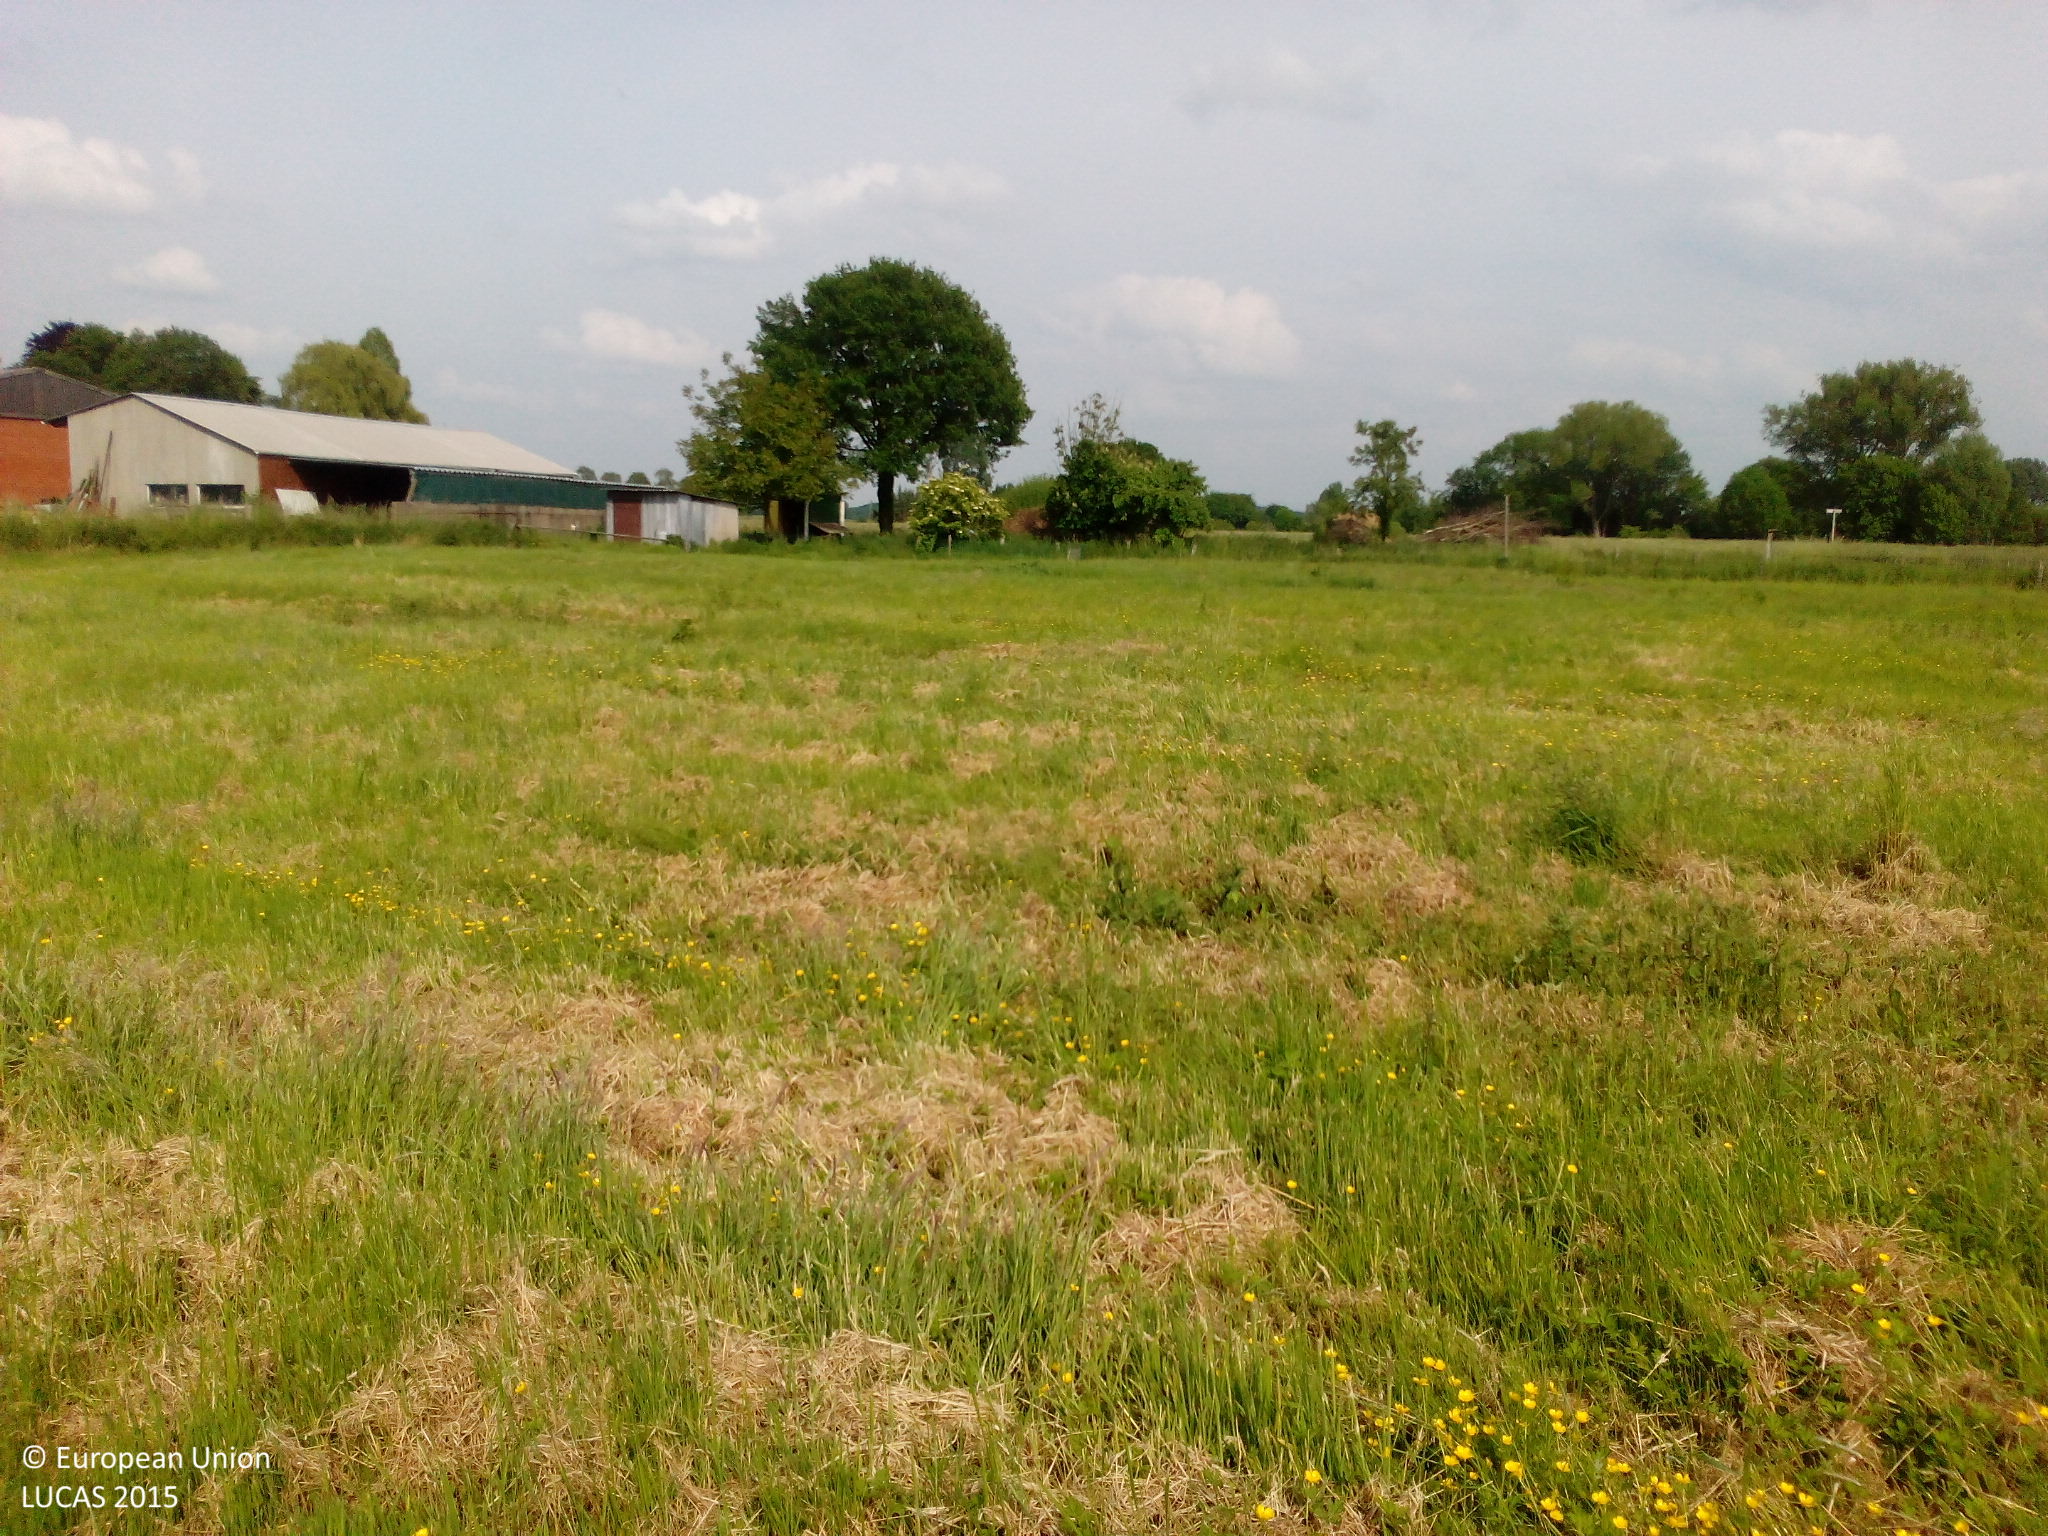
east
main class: Grassland
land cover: Grassland without tree/shrub cover
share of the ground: > 75 %
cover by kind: herbaceous plants 100 %
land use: Agriculture (excluding fallow land and kitchen gardens)
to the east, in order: Grassland without tree/shrub cover; Fences; Shruby margins; Fences; Grassland without tree/shrub cover; Fences; Grassland without tree/shrub cover; Fences; Grassland without tree/shrub cover; Fences; Single bushes/trees; Rivers and streams; Grassland without tree/shrub cover; Single bushes/trees; Grassland without tree/shrub cover; Paved roads, cycling and walking lanes; Fences; Grassland without tree/shrub cover; Abandoned hedges; Fences; Ditches and canals; Abandoned hedges; Fences; Grassland without tree/shrub cover; Fences; Grass margins; Ditches and canals; Grassland without tree/shrub cover; Fences; Grassland without tree/shrub cover
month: June
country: DE
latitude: 51.6408
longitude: 7.9629
